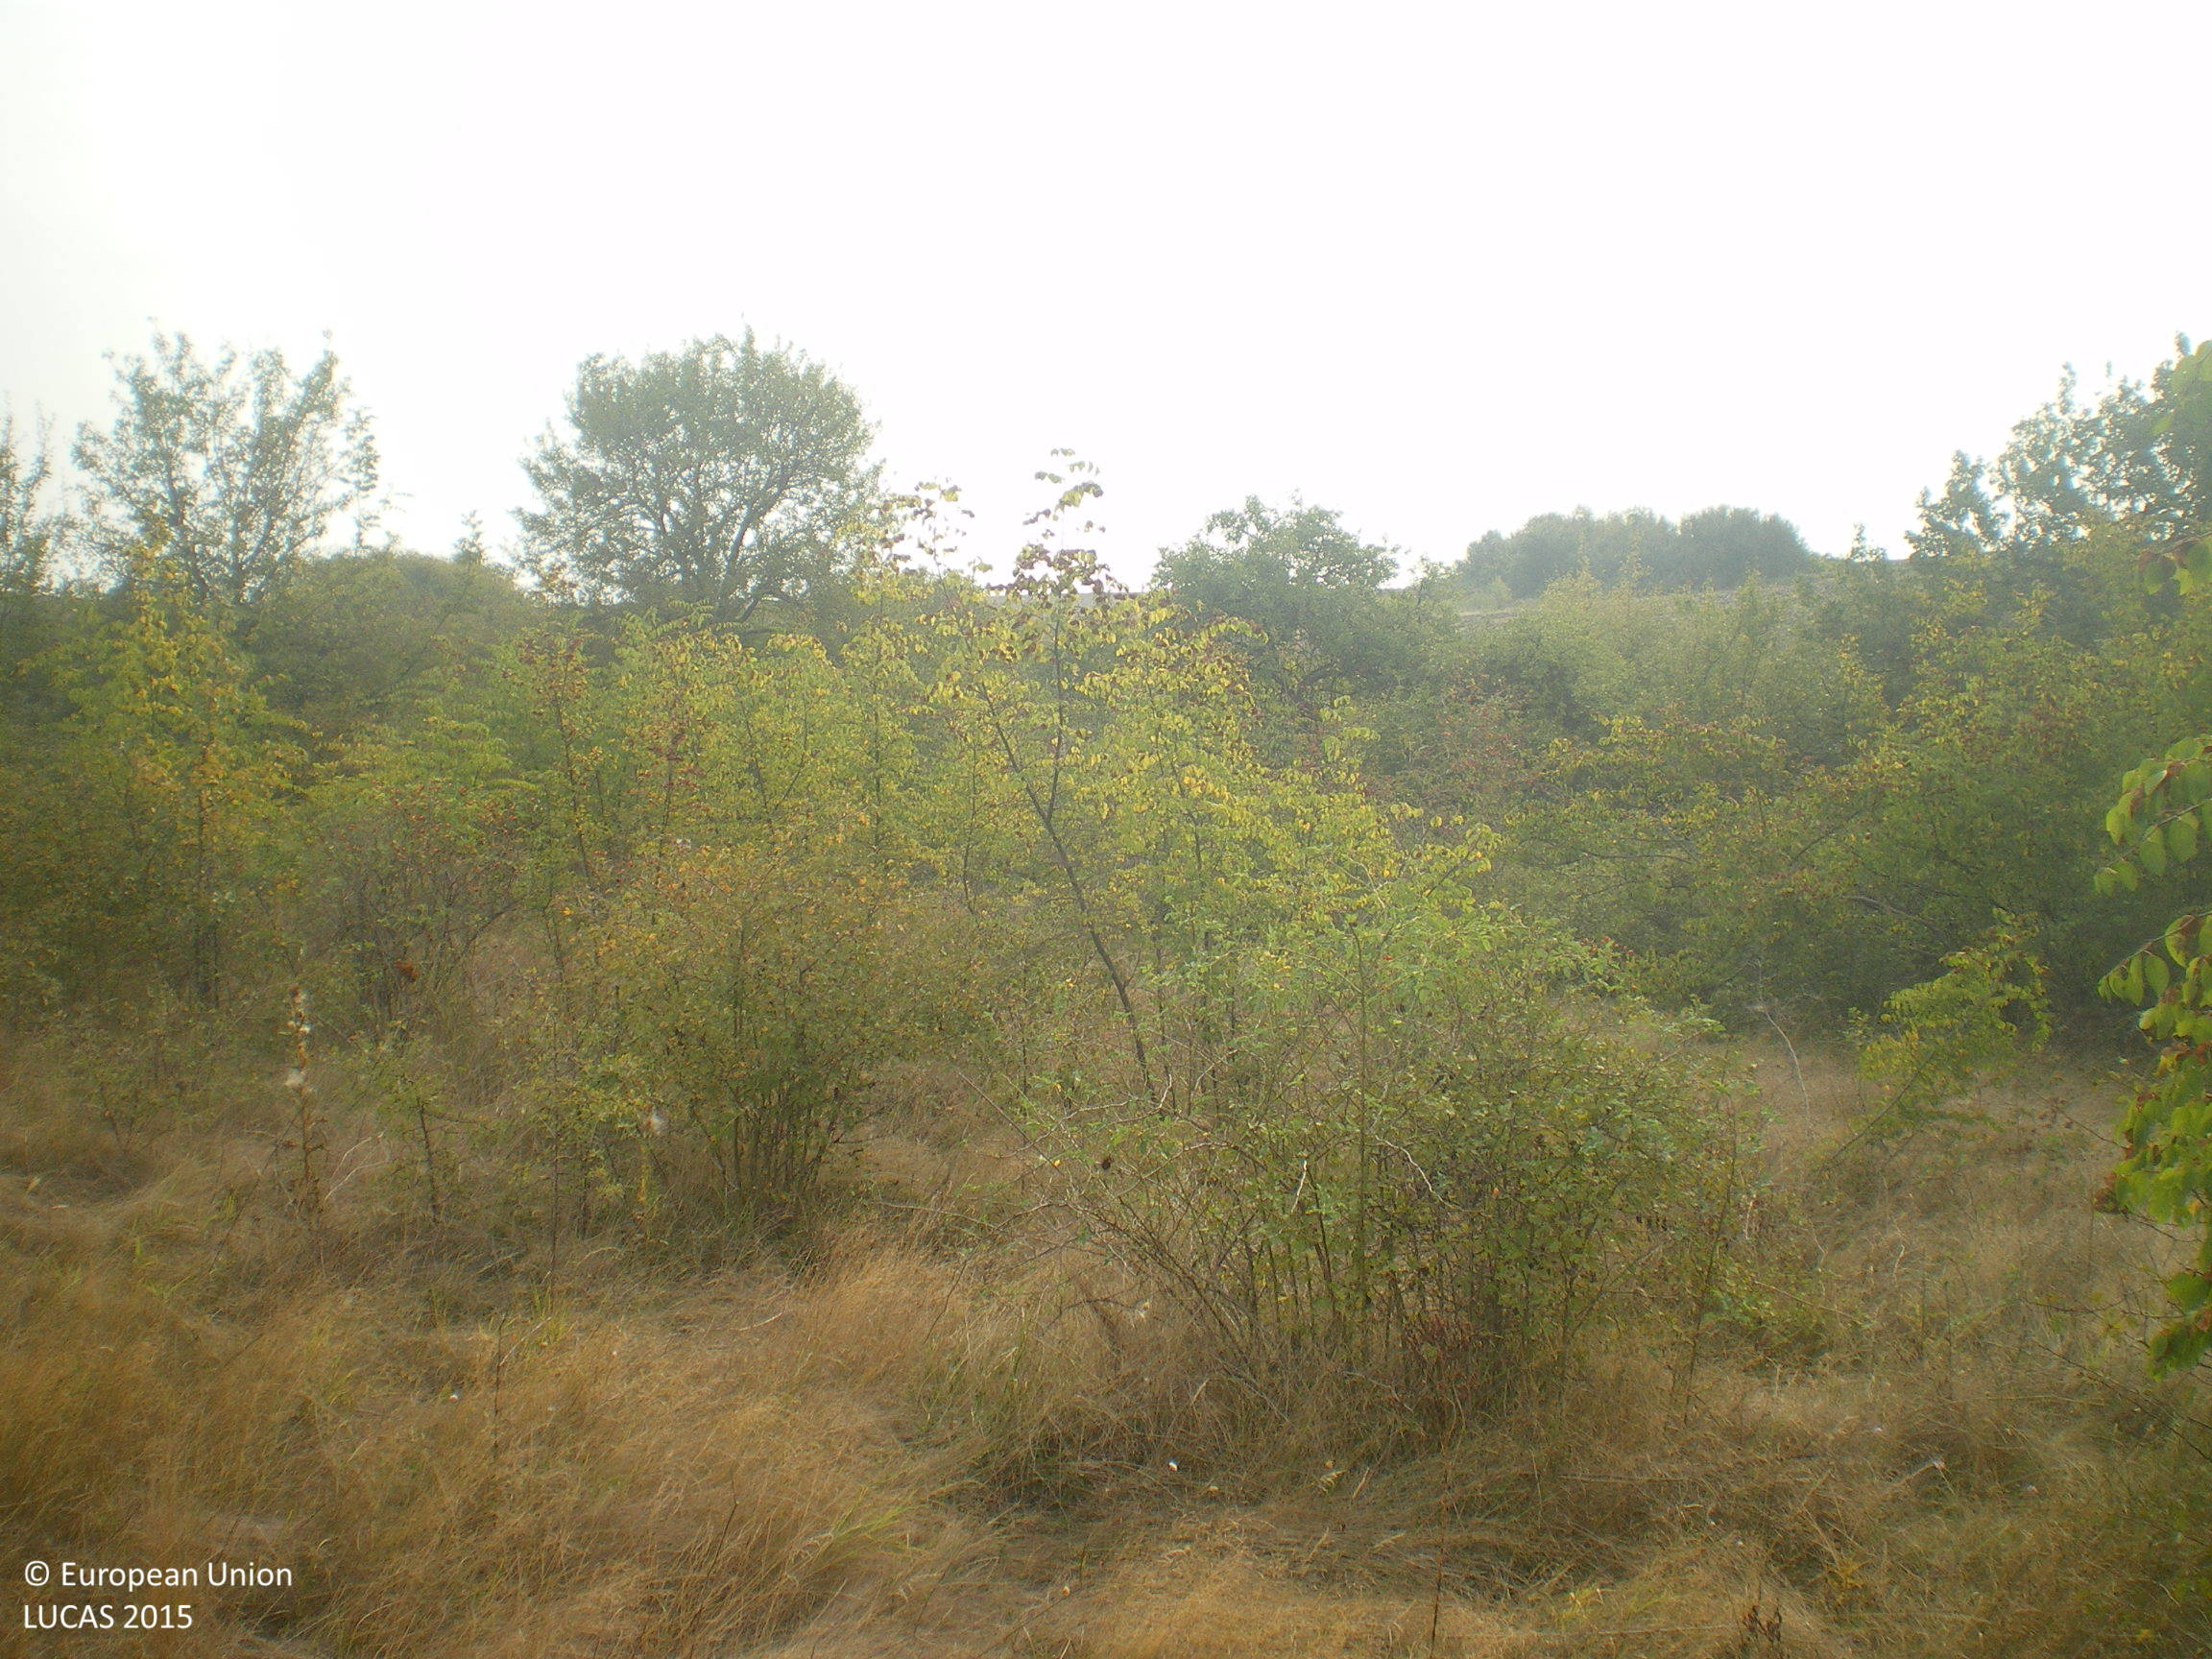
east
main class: Grassland
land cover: Grassland with sparse tree/shrub cover
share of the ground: > 75 %
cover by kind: herbaceous plants 90 %, broadleaved forest trees 5 %, shrubs 5 %
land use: Agriculture (excluding fallow land and kitchen gardens)
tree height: > 5 m
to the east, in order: Grassland with sparse tree/shrub cover; Shrubland with sparse tree cover; Broadleaved woodland; Sunflower; Shrubland without tree cover; Tracks; Sunflower
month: September
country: BG
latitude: 42.1009
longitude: 25.9267
